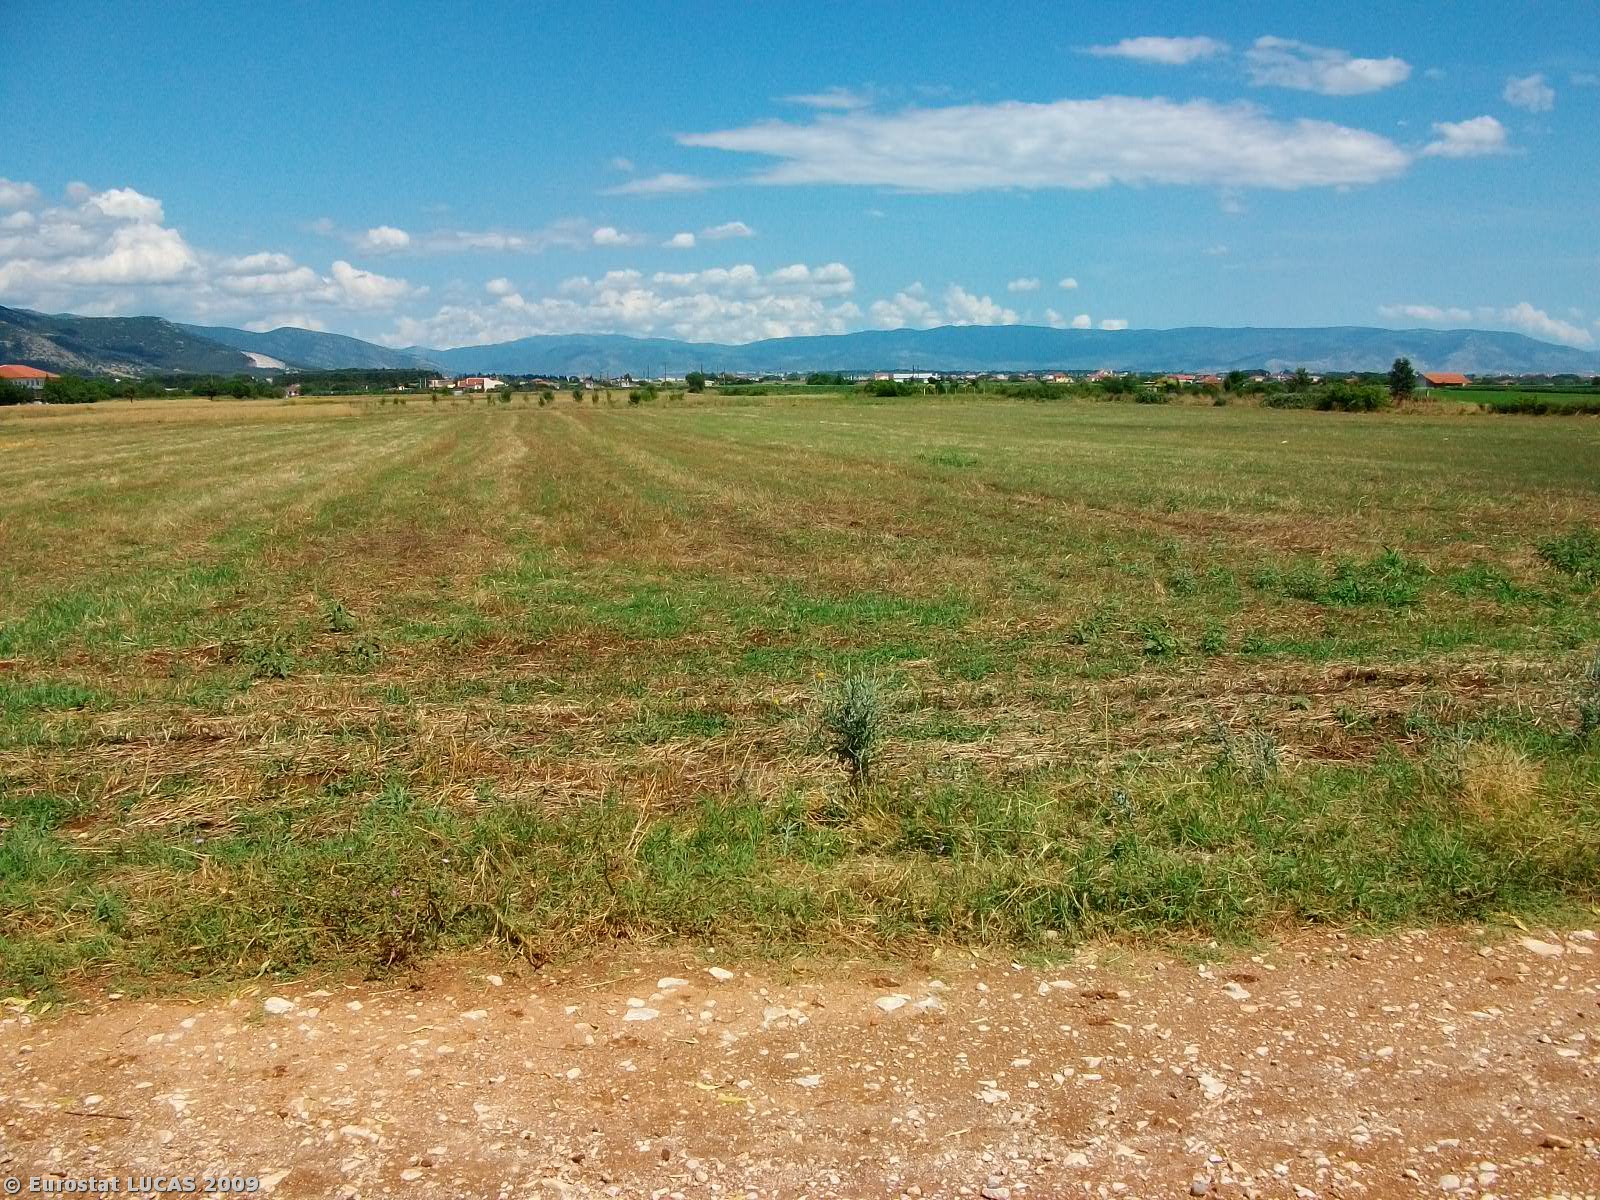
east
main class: Cropland
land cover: Nuts trees
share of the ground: 50 - 75 %
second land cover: Grassland with sparse tree/shrub cover
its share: > 75 %
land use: Kitchen garden
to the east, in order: Nuts trees; Grassland with sparse tree/shrub cover; Fences; Grass margins; Tracks; Electric lines; Grassland without tree/shrub cover; Fences; Grassland with sparse tree/shrub cover
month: June
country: GR
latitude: 41.1493
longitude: 24.1008
